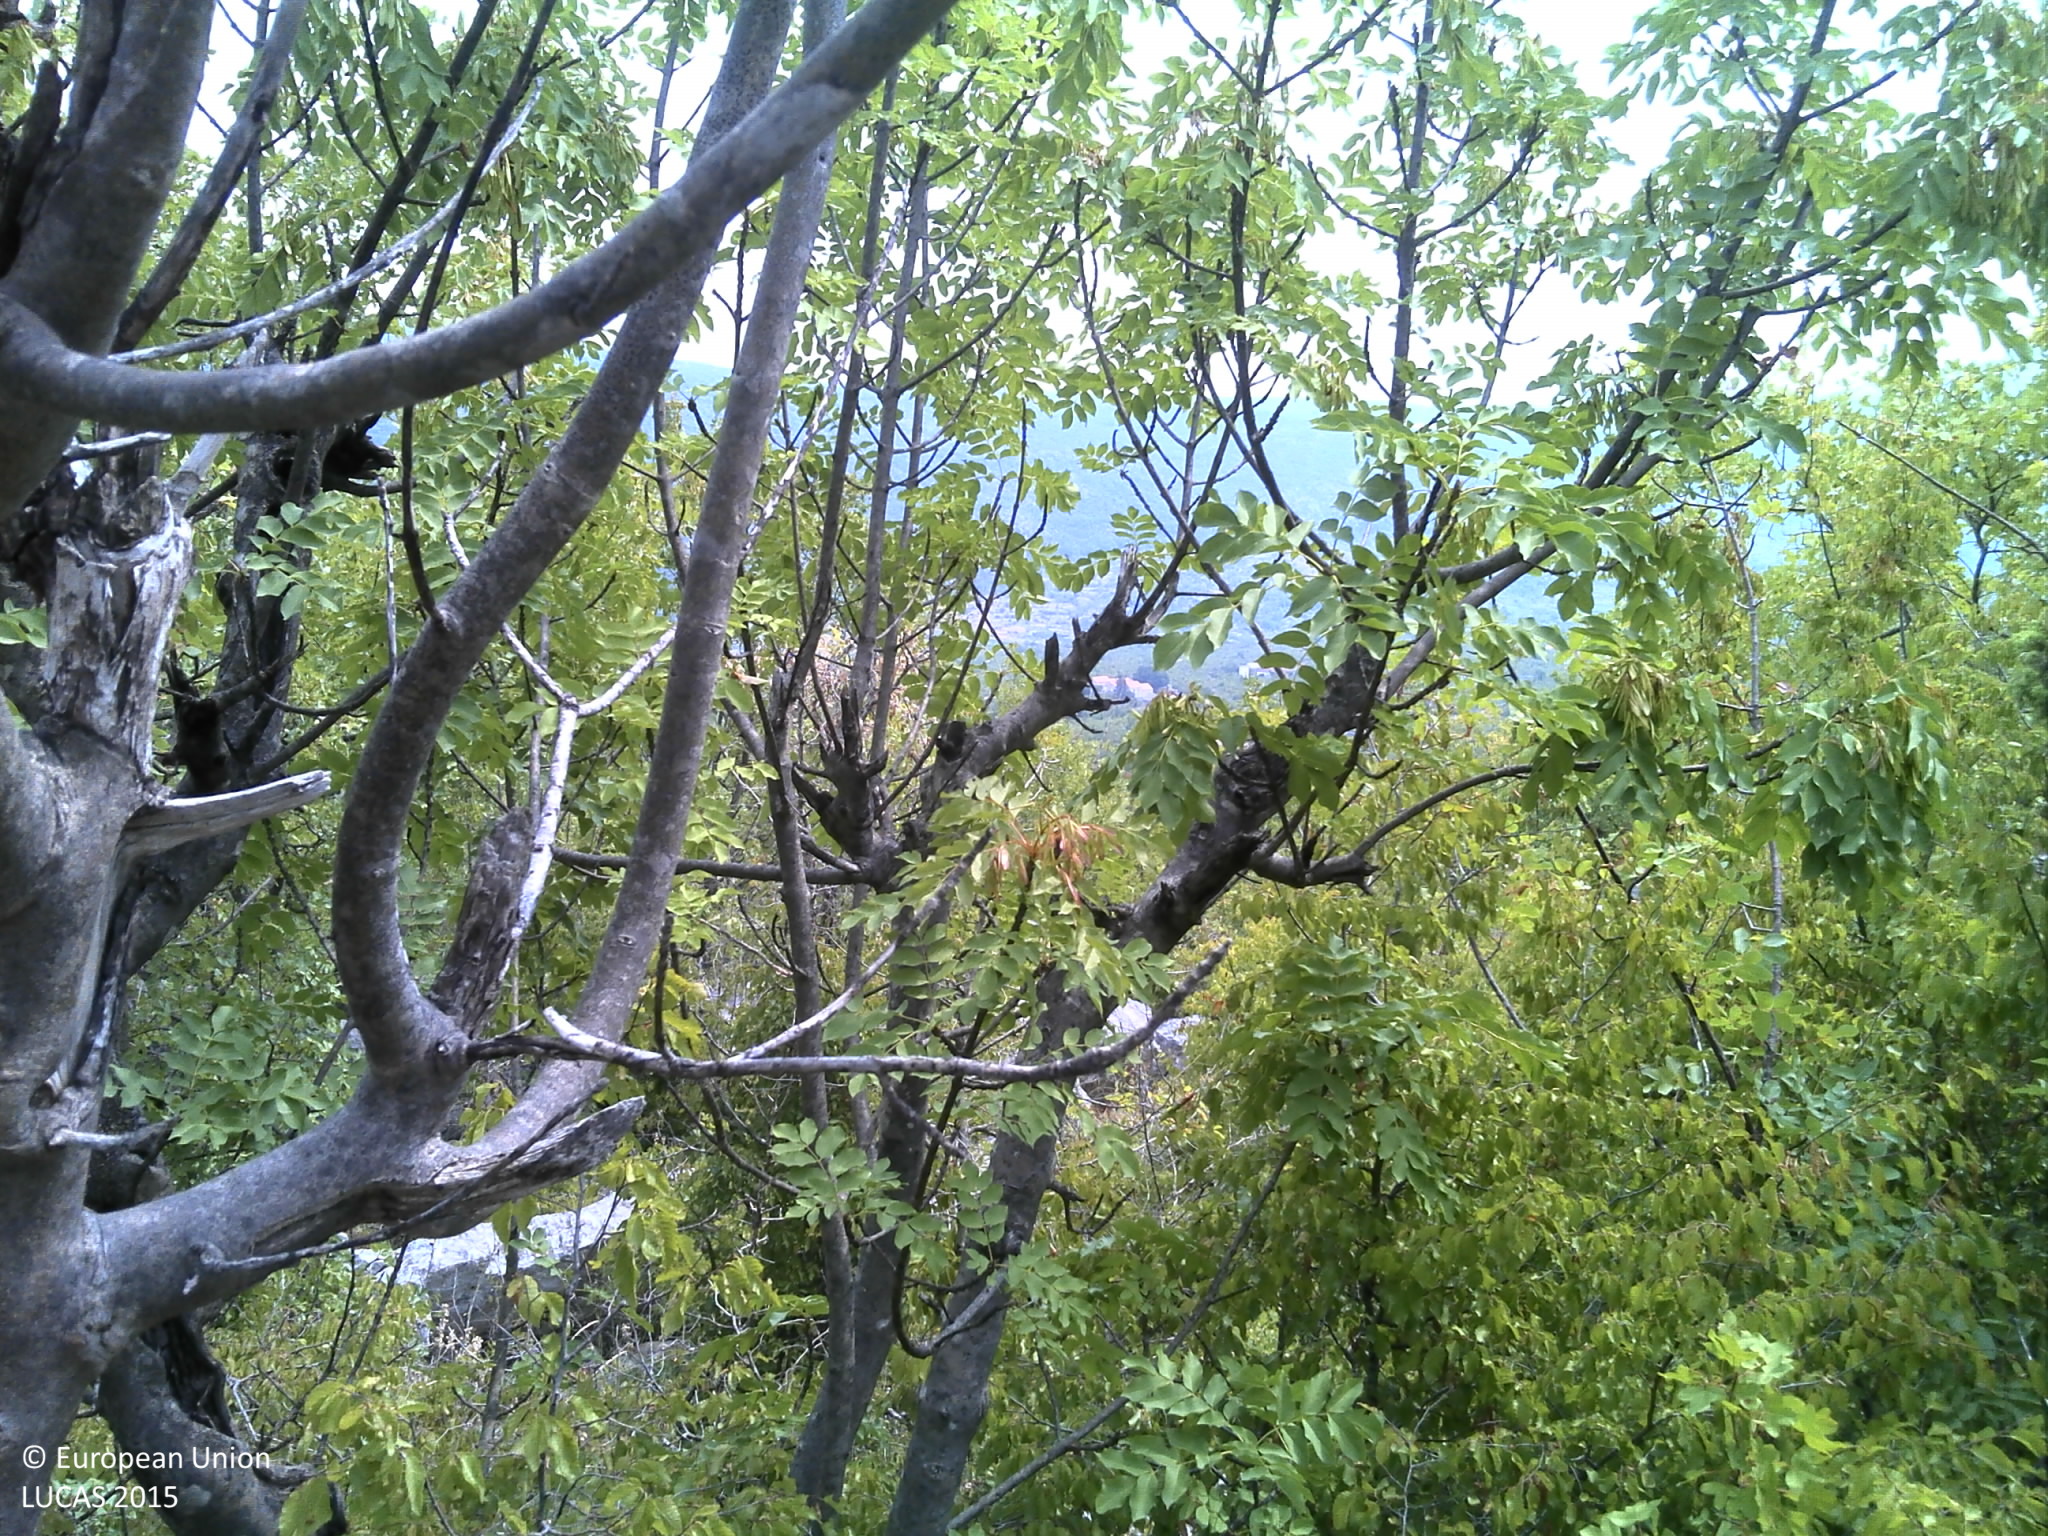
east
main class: Shrubland
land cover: Shrubland with sparse tree cover
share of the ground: 50 - 75 %
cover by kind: shrubs 70 %, consolidated bare surface 10 %, unconsolidated bare surface 10 %, broadleaved forest trees 5 %, herbaceous plants 5 %
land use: Semi-natural and natural areas not in use
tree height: < 5 m
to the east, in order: Shrubland with sparse tree cover; Dry stone walls; Shrubland with sparse tree cover; Dry stone walls; Shrubland with sparse tree cover; Grassland with sparse tree/shrub cover; Dry stone walls; Tracks; Dry stone walls; Broadleaved woodland; Dry stone walls; Artificial constructions in urban areas; Grassland without tree/shrub cover; Dry stone walls; Grassland without tree/shrub cover
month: August
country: HR
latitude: 43.3068
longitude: 17.1538
